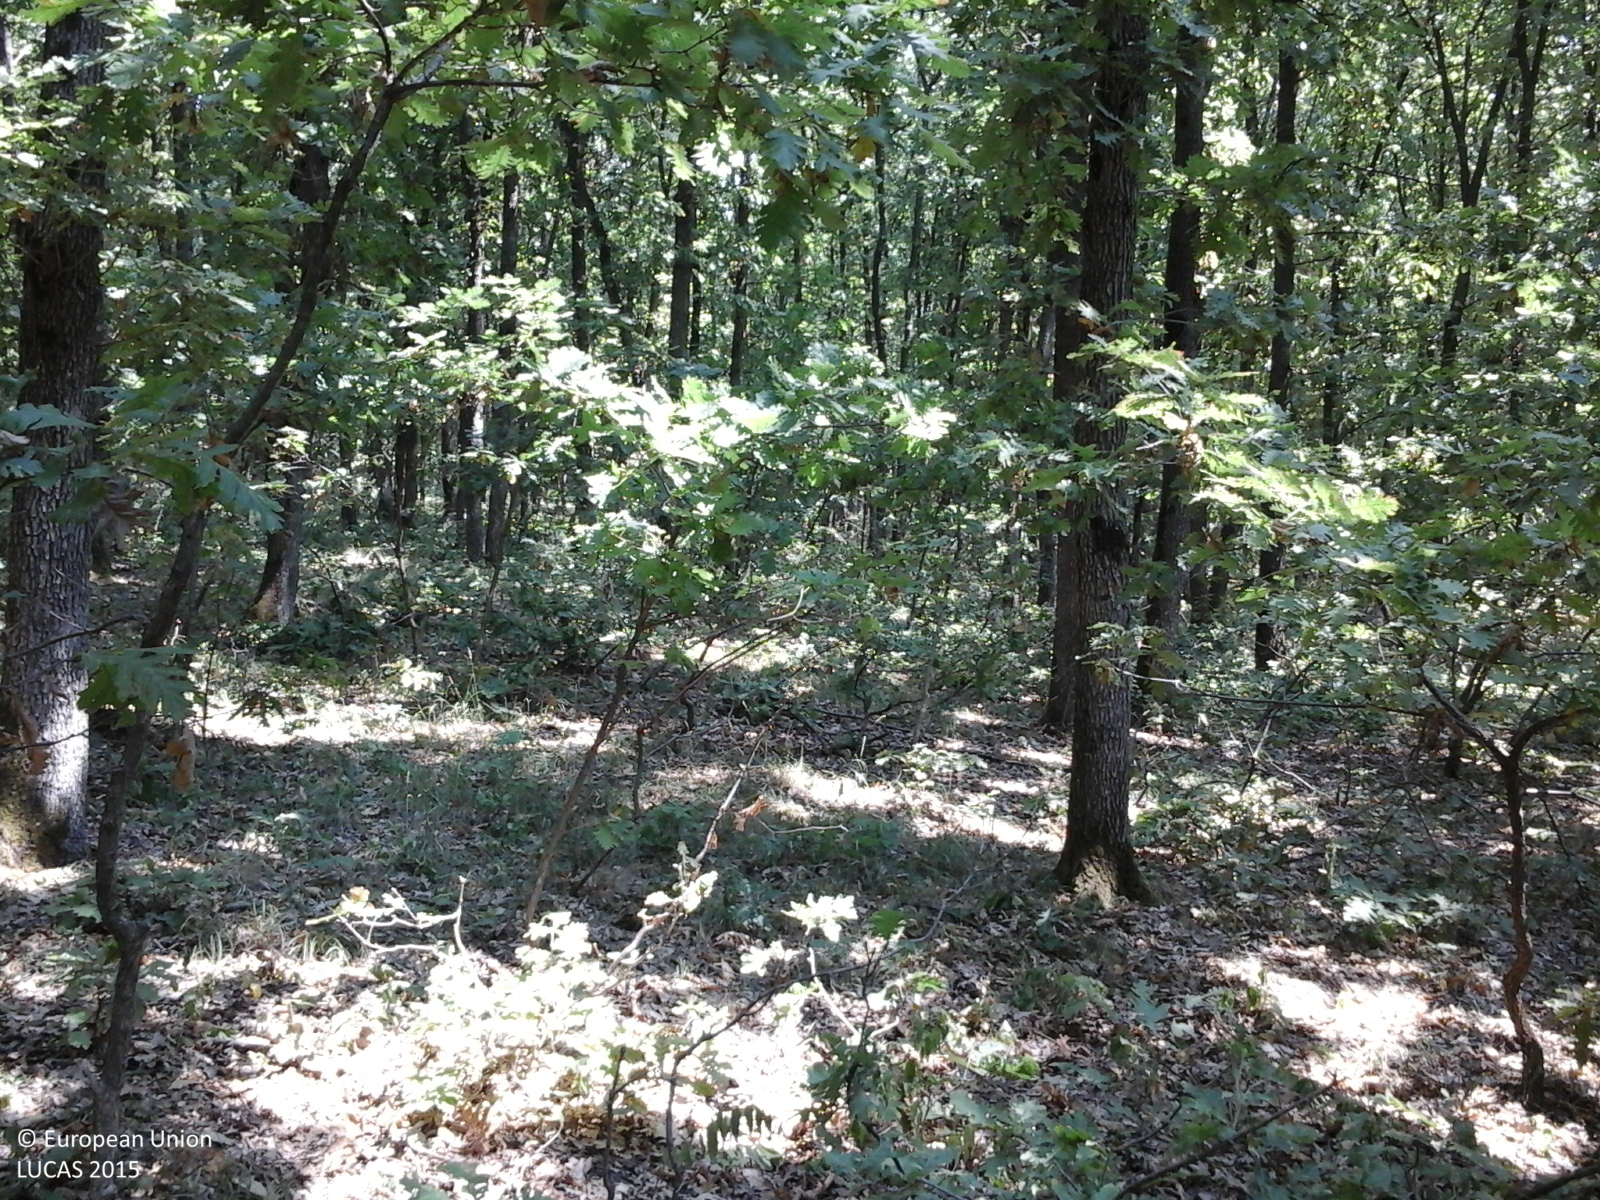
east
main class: Woodland
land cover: Broadleaved woodland
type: acidophilous oak and oak-birch forest
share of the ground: > 75 %
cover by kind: broadleaved forest trees 100 %
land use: Forestry
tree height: > 5 m
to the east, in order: Broadleaved woodland; Tracks; Broadleaved woodland
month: August
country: RO
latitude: 44.5082
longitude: 23.4745
